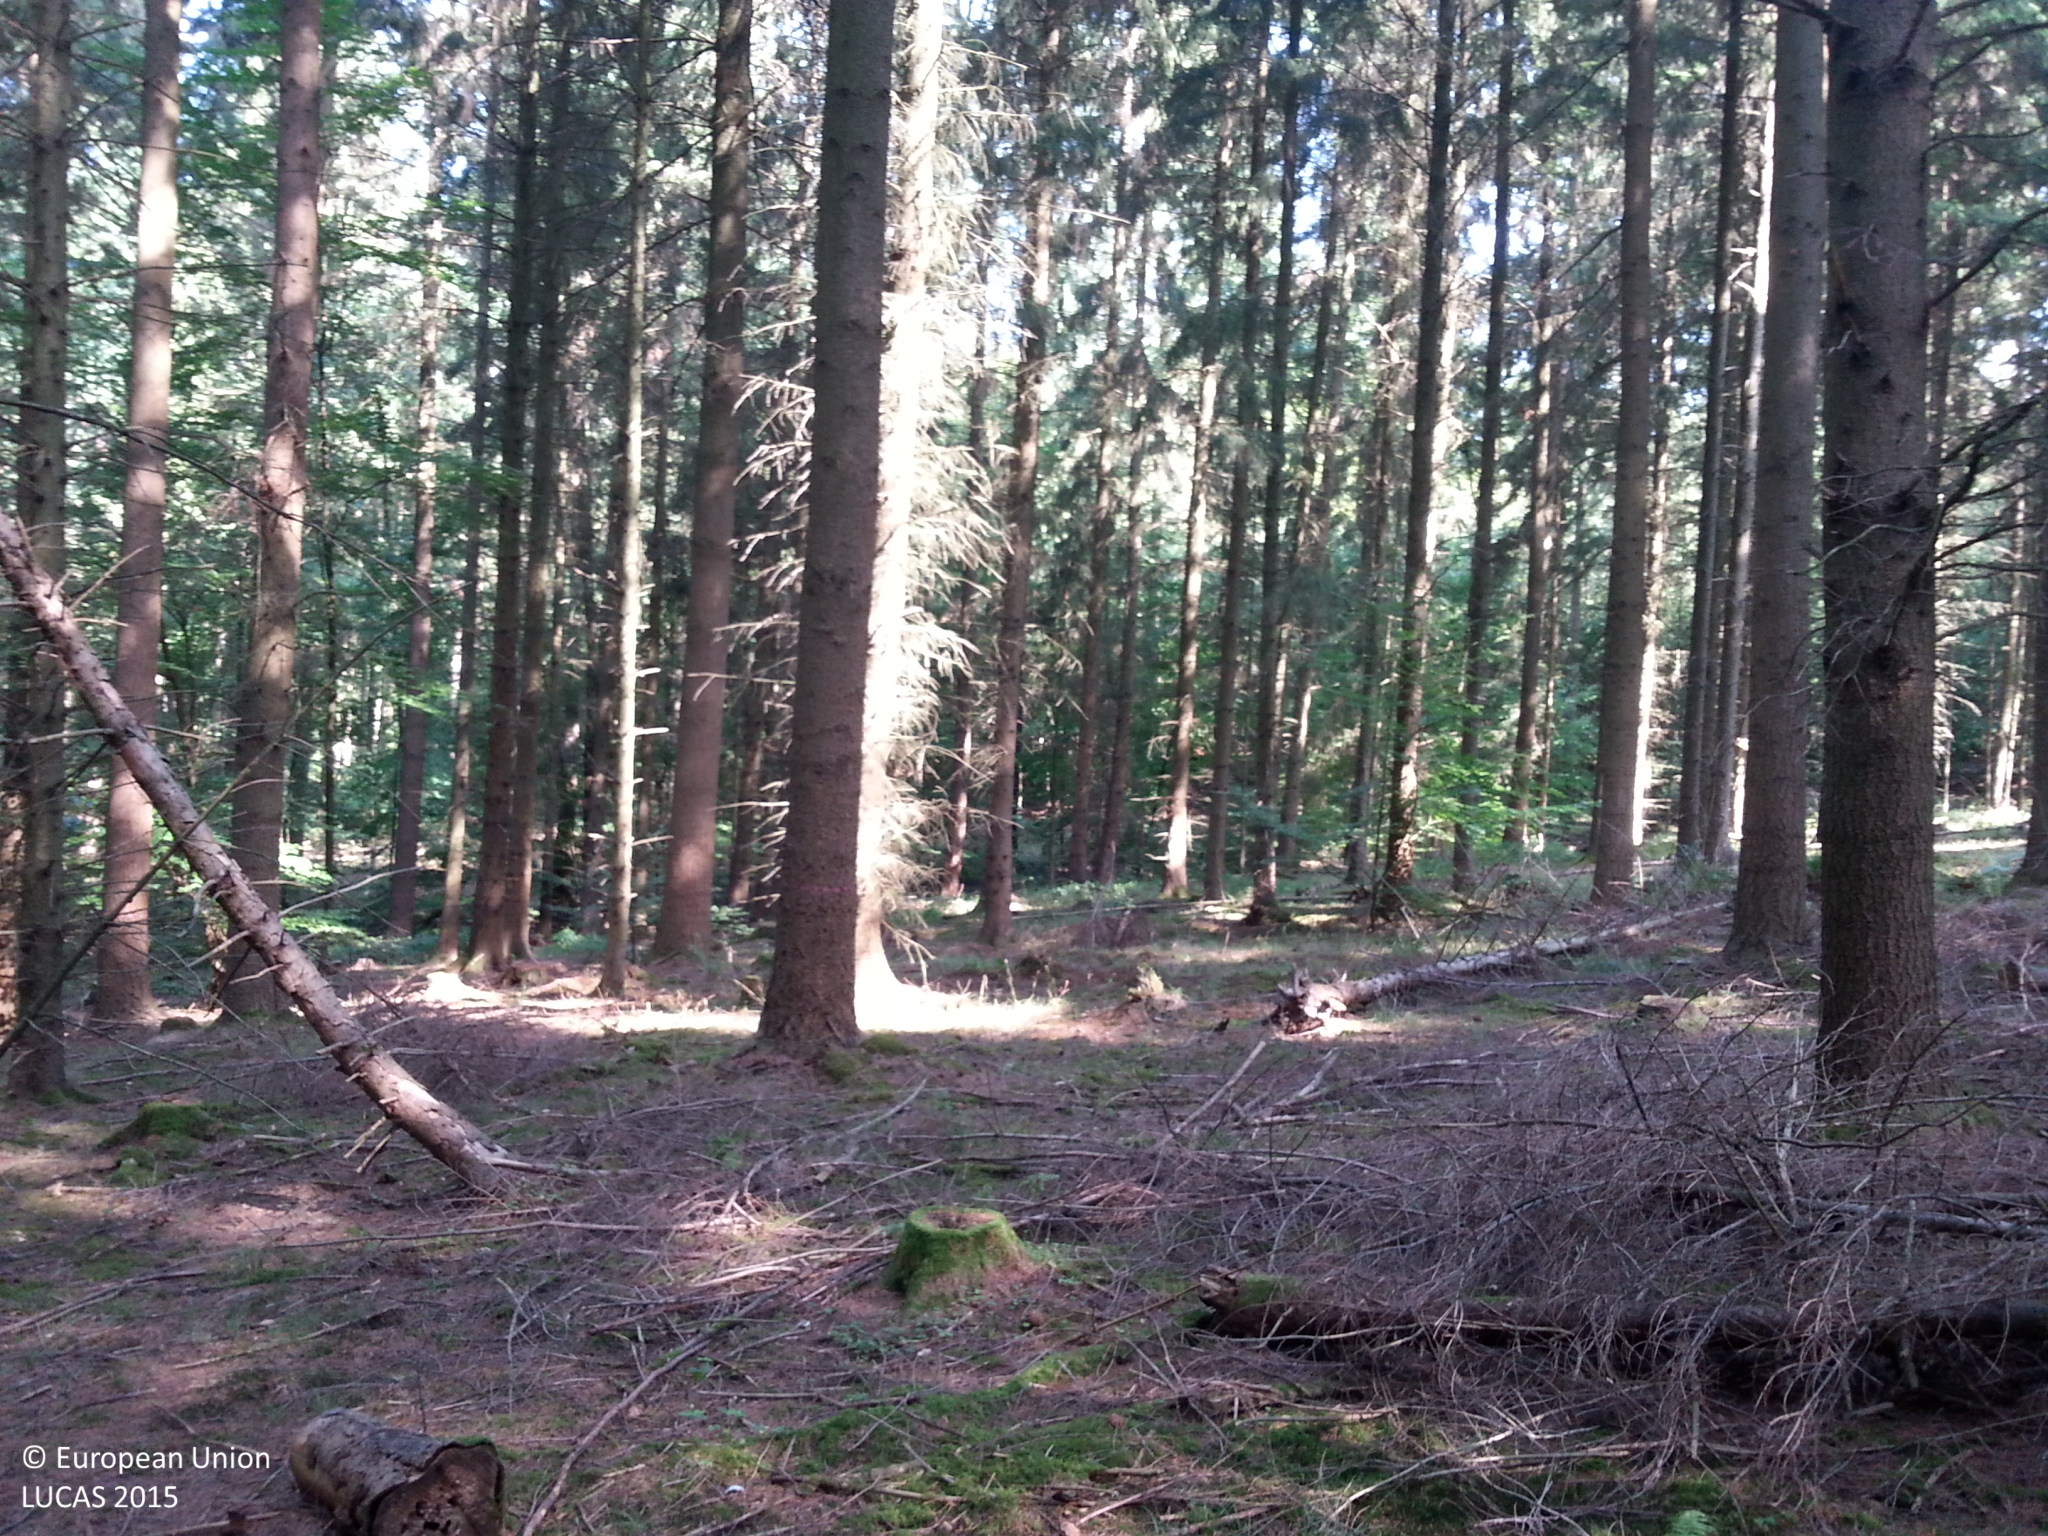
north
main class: Woodland
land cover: Spruce dominated coniferous woodland
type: boreal forest
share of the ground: > 75 %
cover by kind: coniferous forest trees 80 %, herbaceous plants 10 %, lichens and mosses 10 %
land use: Forestry
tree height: > 5 m
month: September
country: DE
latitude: 49.3554
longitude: 9.4082
